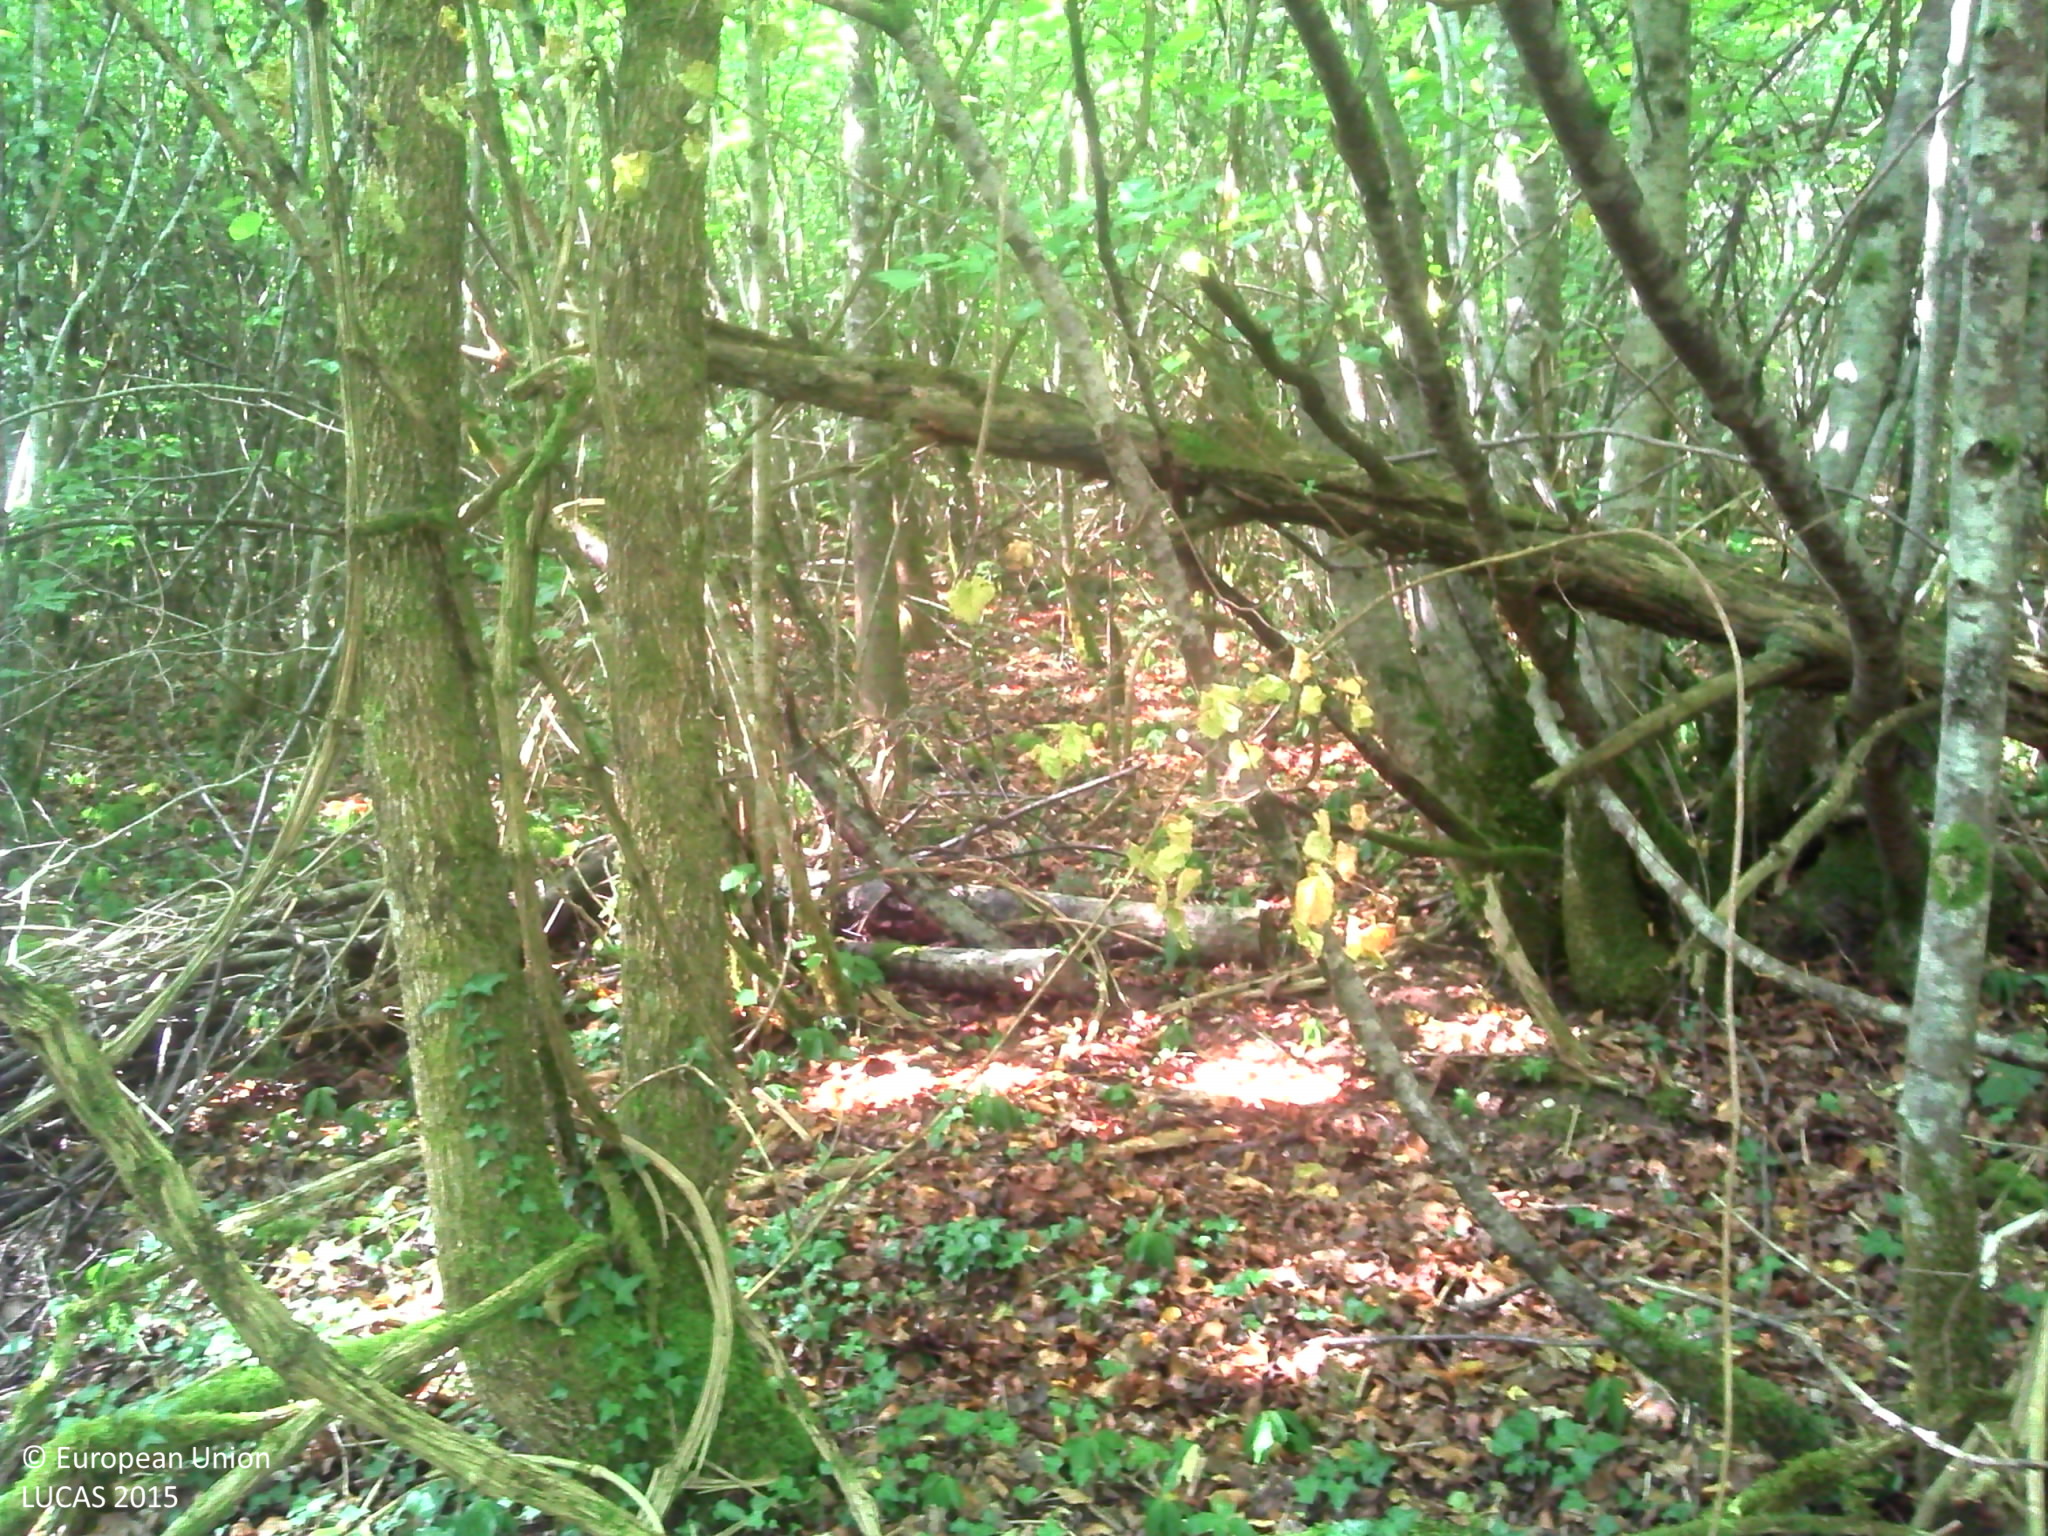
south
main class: Woodland
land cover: Broadleaved woodland
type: beech forest
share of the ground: > 75 %
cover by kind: broadleaved forest trees 85 %, coniferous forest trees 5 %, herbaceous plants 5 %, lichens and mosses 5 %
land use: Forestry
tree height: > 5 m
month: July
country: FR
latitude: 47.9958
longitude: 4.8661
